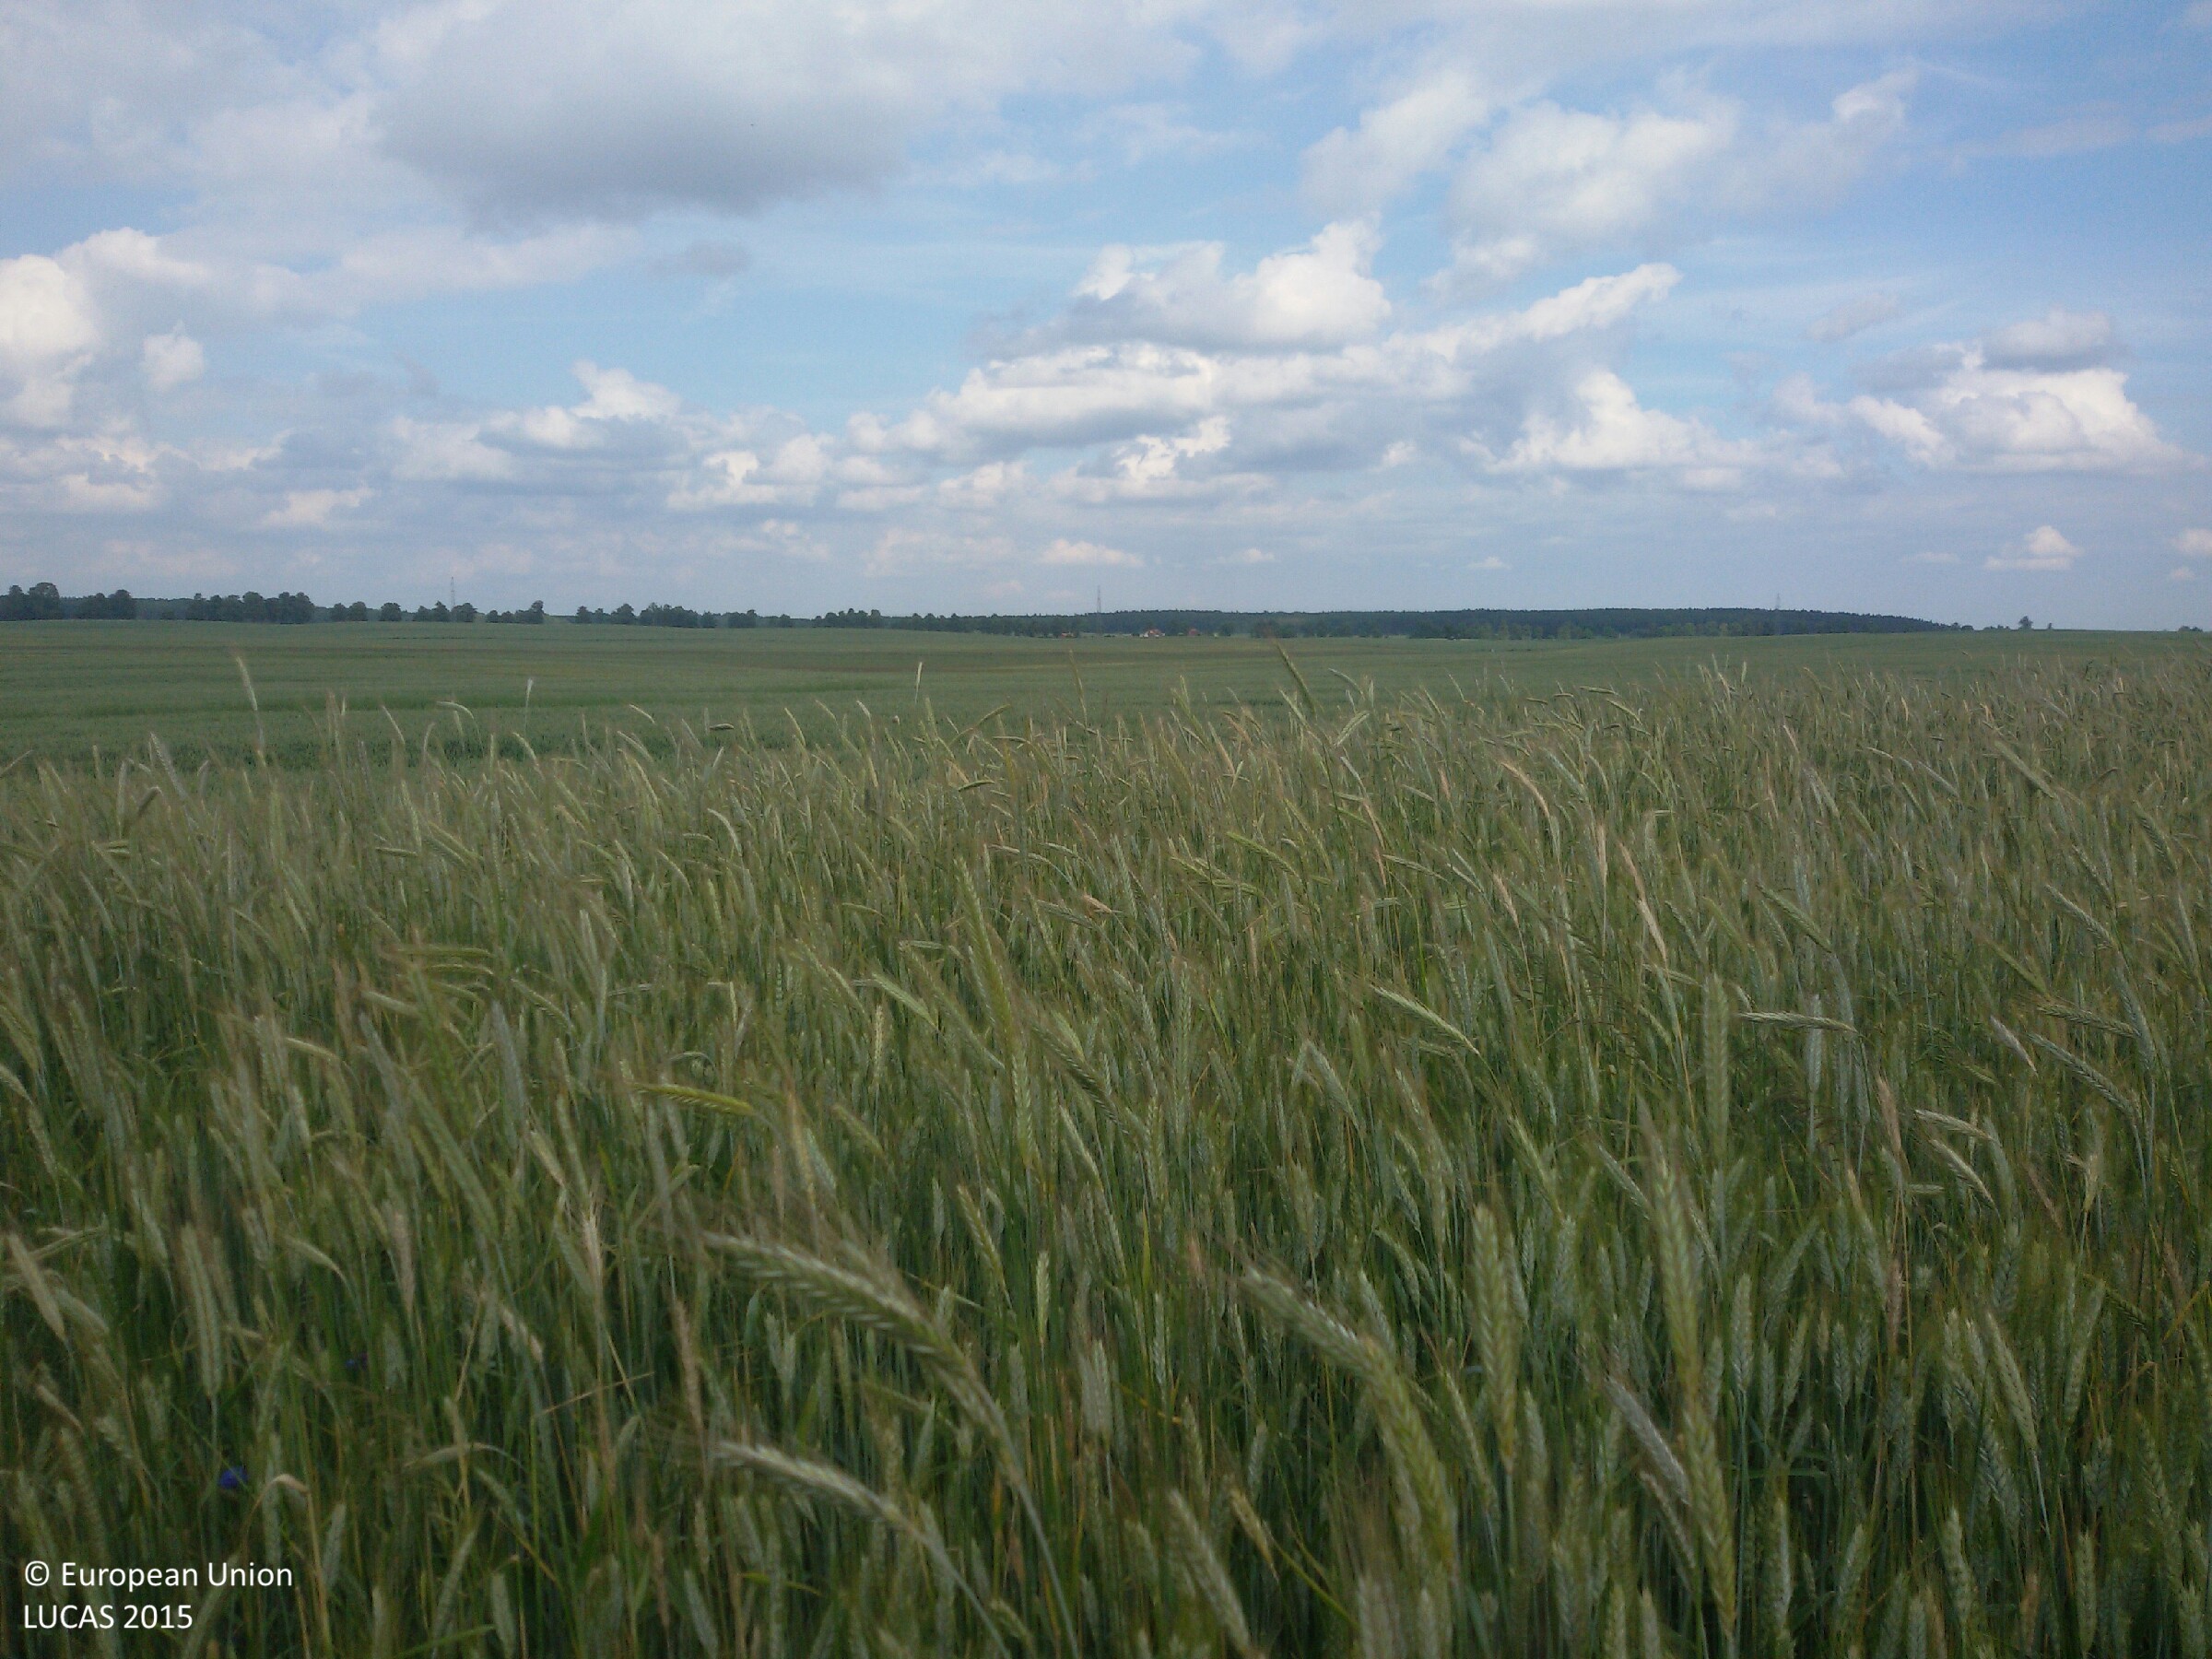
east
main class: Cropland
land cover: Rye
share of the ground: > 75 %
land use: Agriculture (excluding fallow land and kitchen gardens)
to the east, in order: Rye; Common wheat
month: June
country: PL
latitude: 53.6611
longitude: 19.2706
